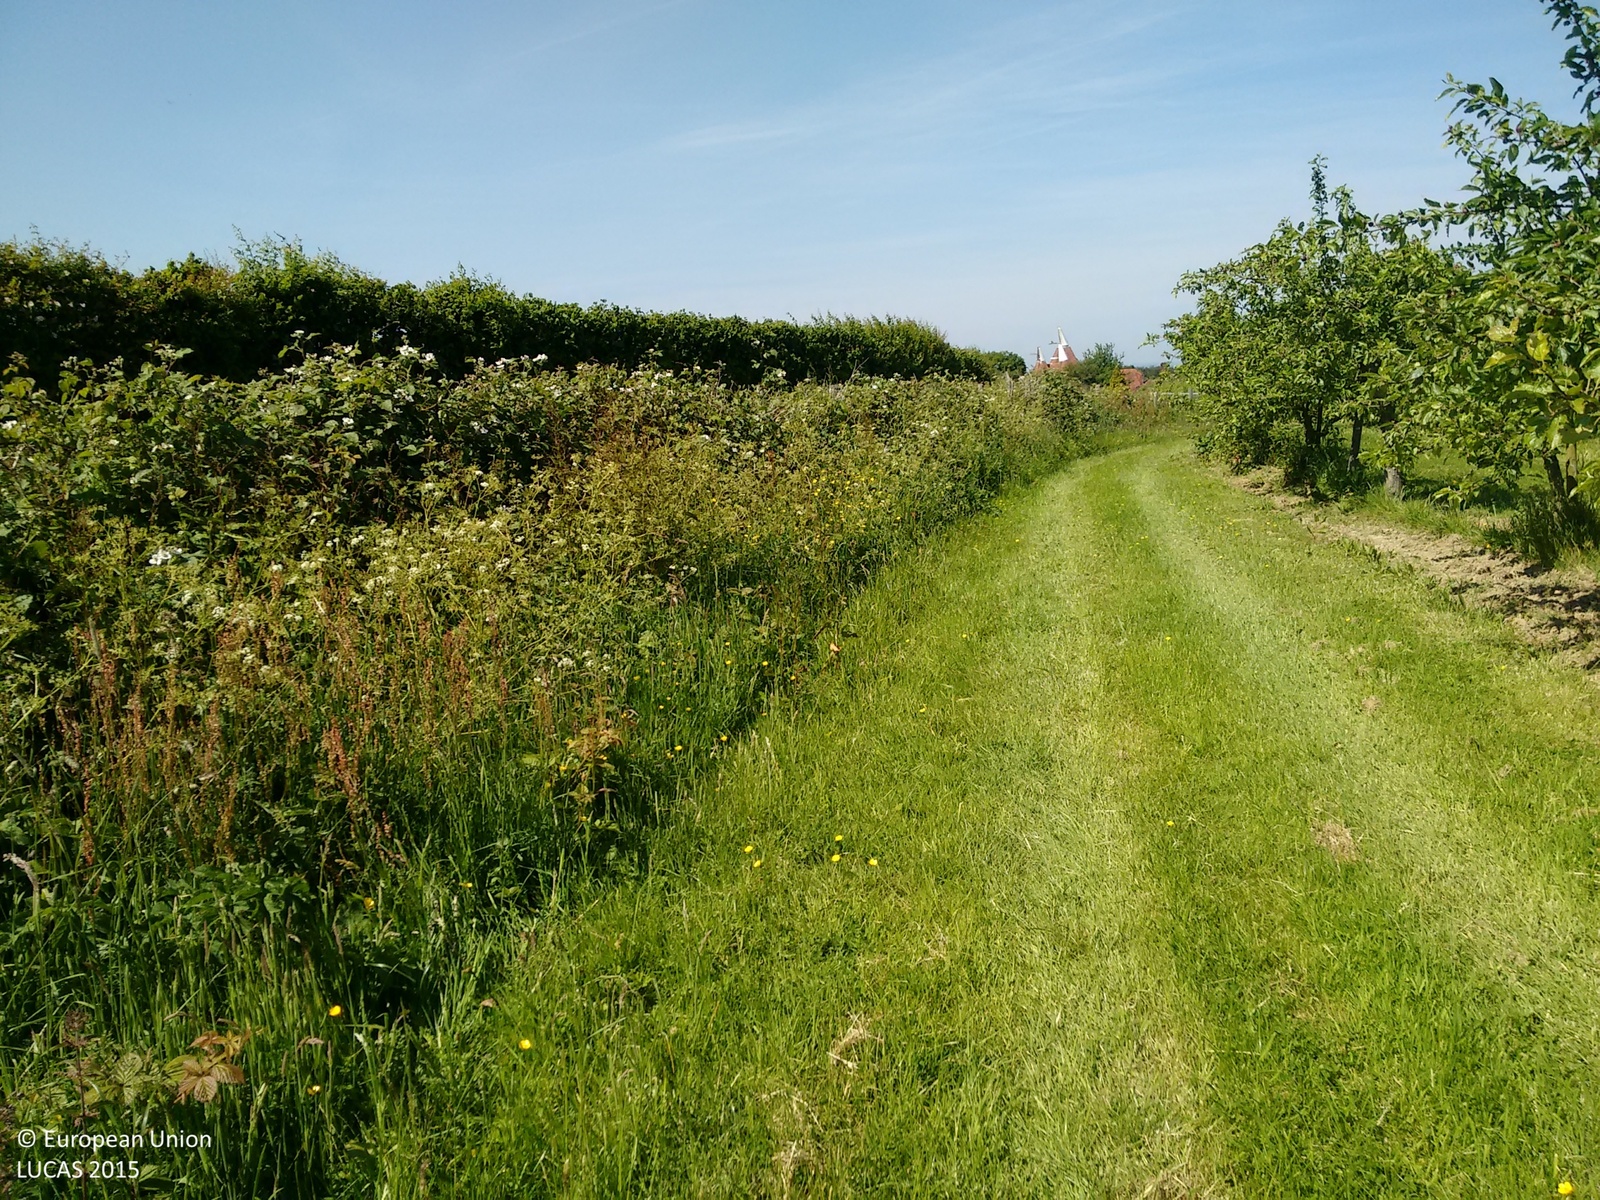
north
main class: Cropland
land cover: Apple fruit
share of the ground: 50 - 75 %
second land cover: Grassland without tree/shrub cover
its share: 50 - 75 %
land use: Agriculture (excluding fallow land and kitchen gardens)
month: June
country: GB
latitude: 51.1088
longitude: 0.5024
